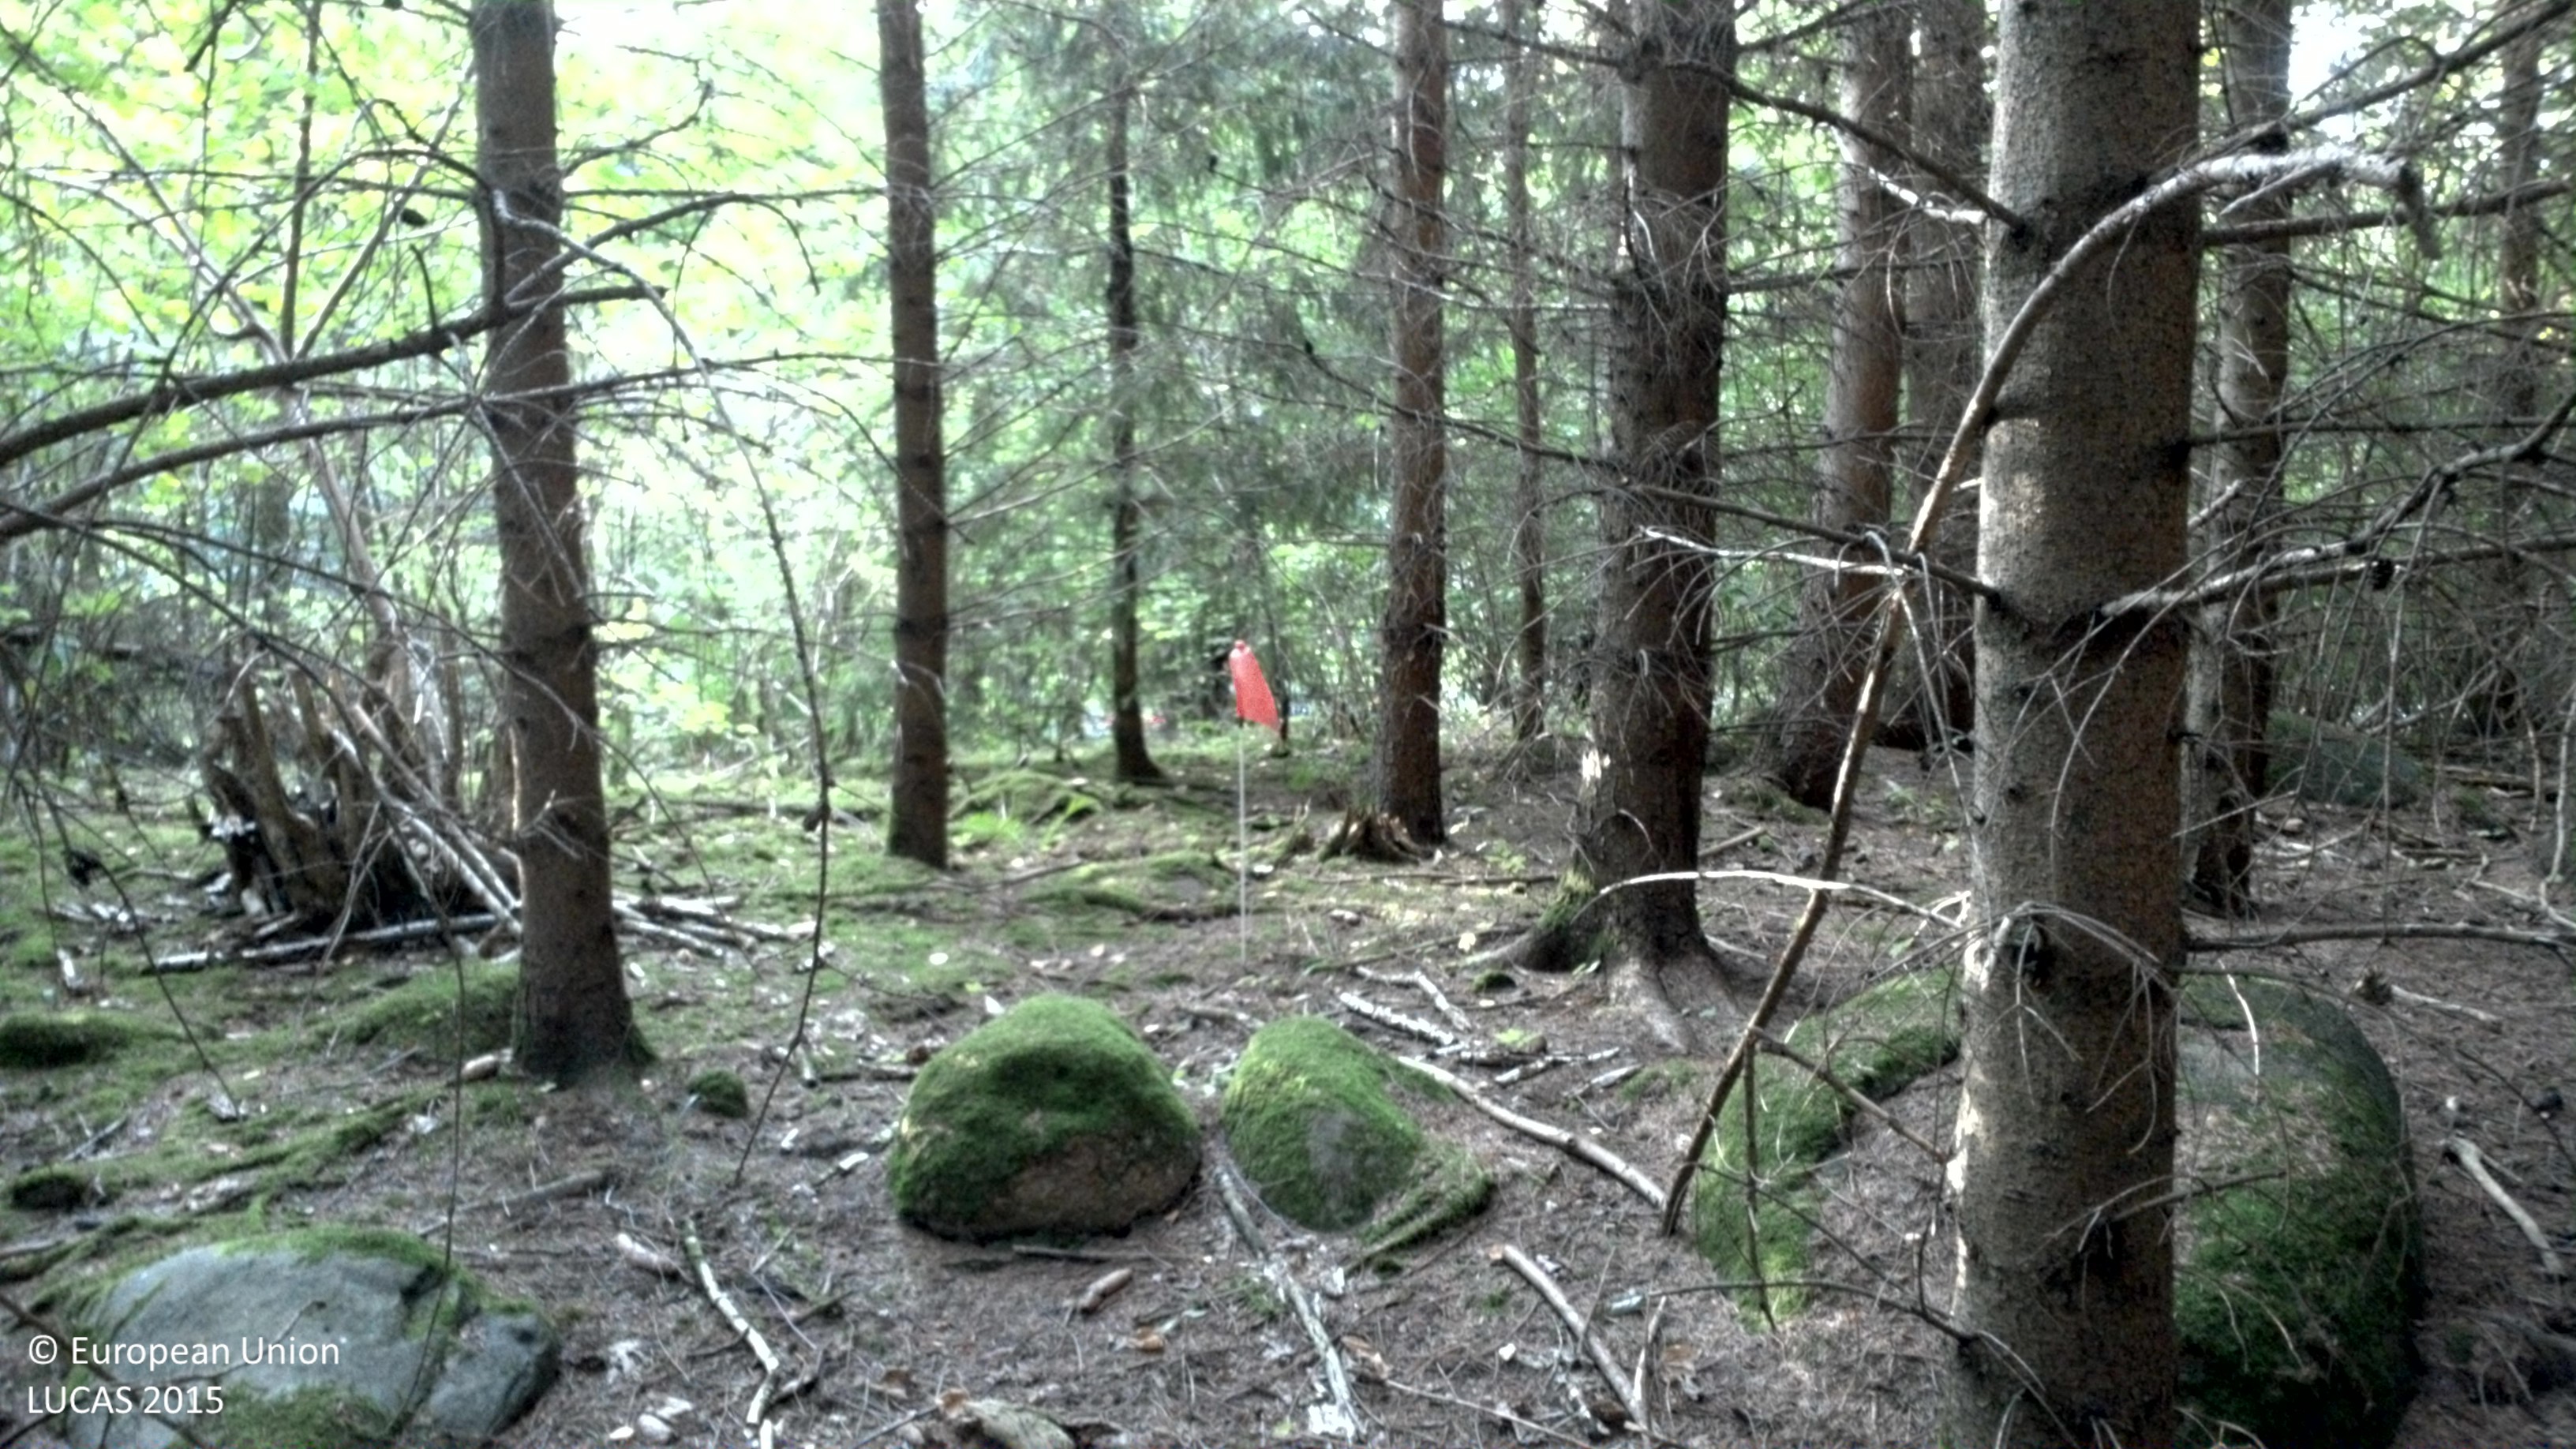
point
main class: Woodland
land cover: Spruce dominated coniferous woodland
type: boreal forest
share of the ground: > 75 %
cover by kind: coniferous forest trees 90 %, lichens and mosses 5 %, unconsolidated bare surface 5 %
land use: Forestry
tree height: > 5 m
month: September
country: SE
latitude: 56.1351
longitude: 14.2620
